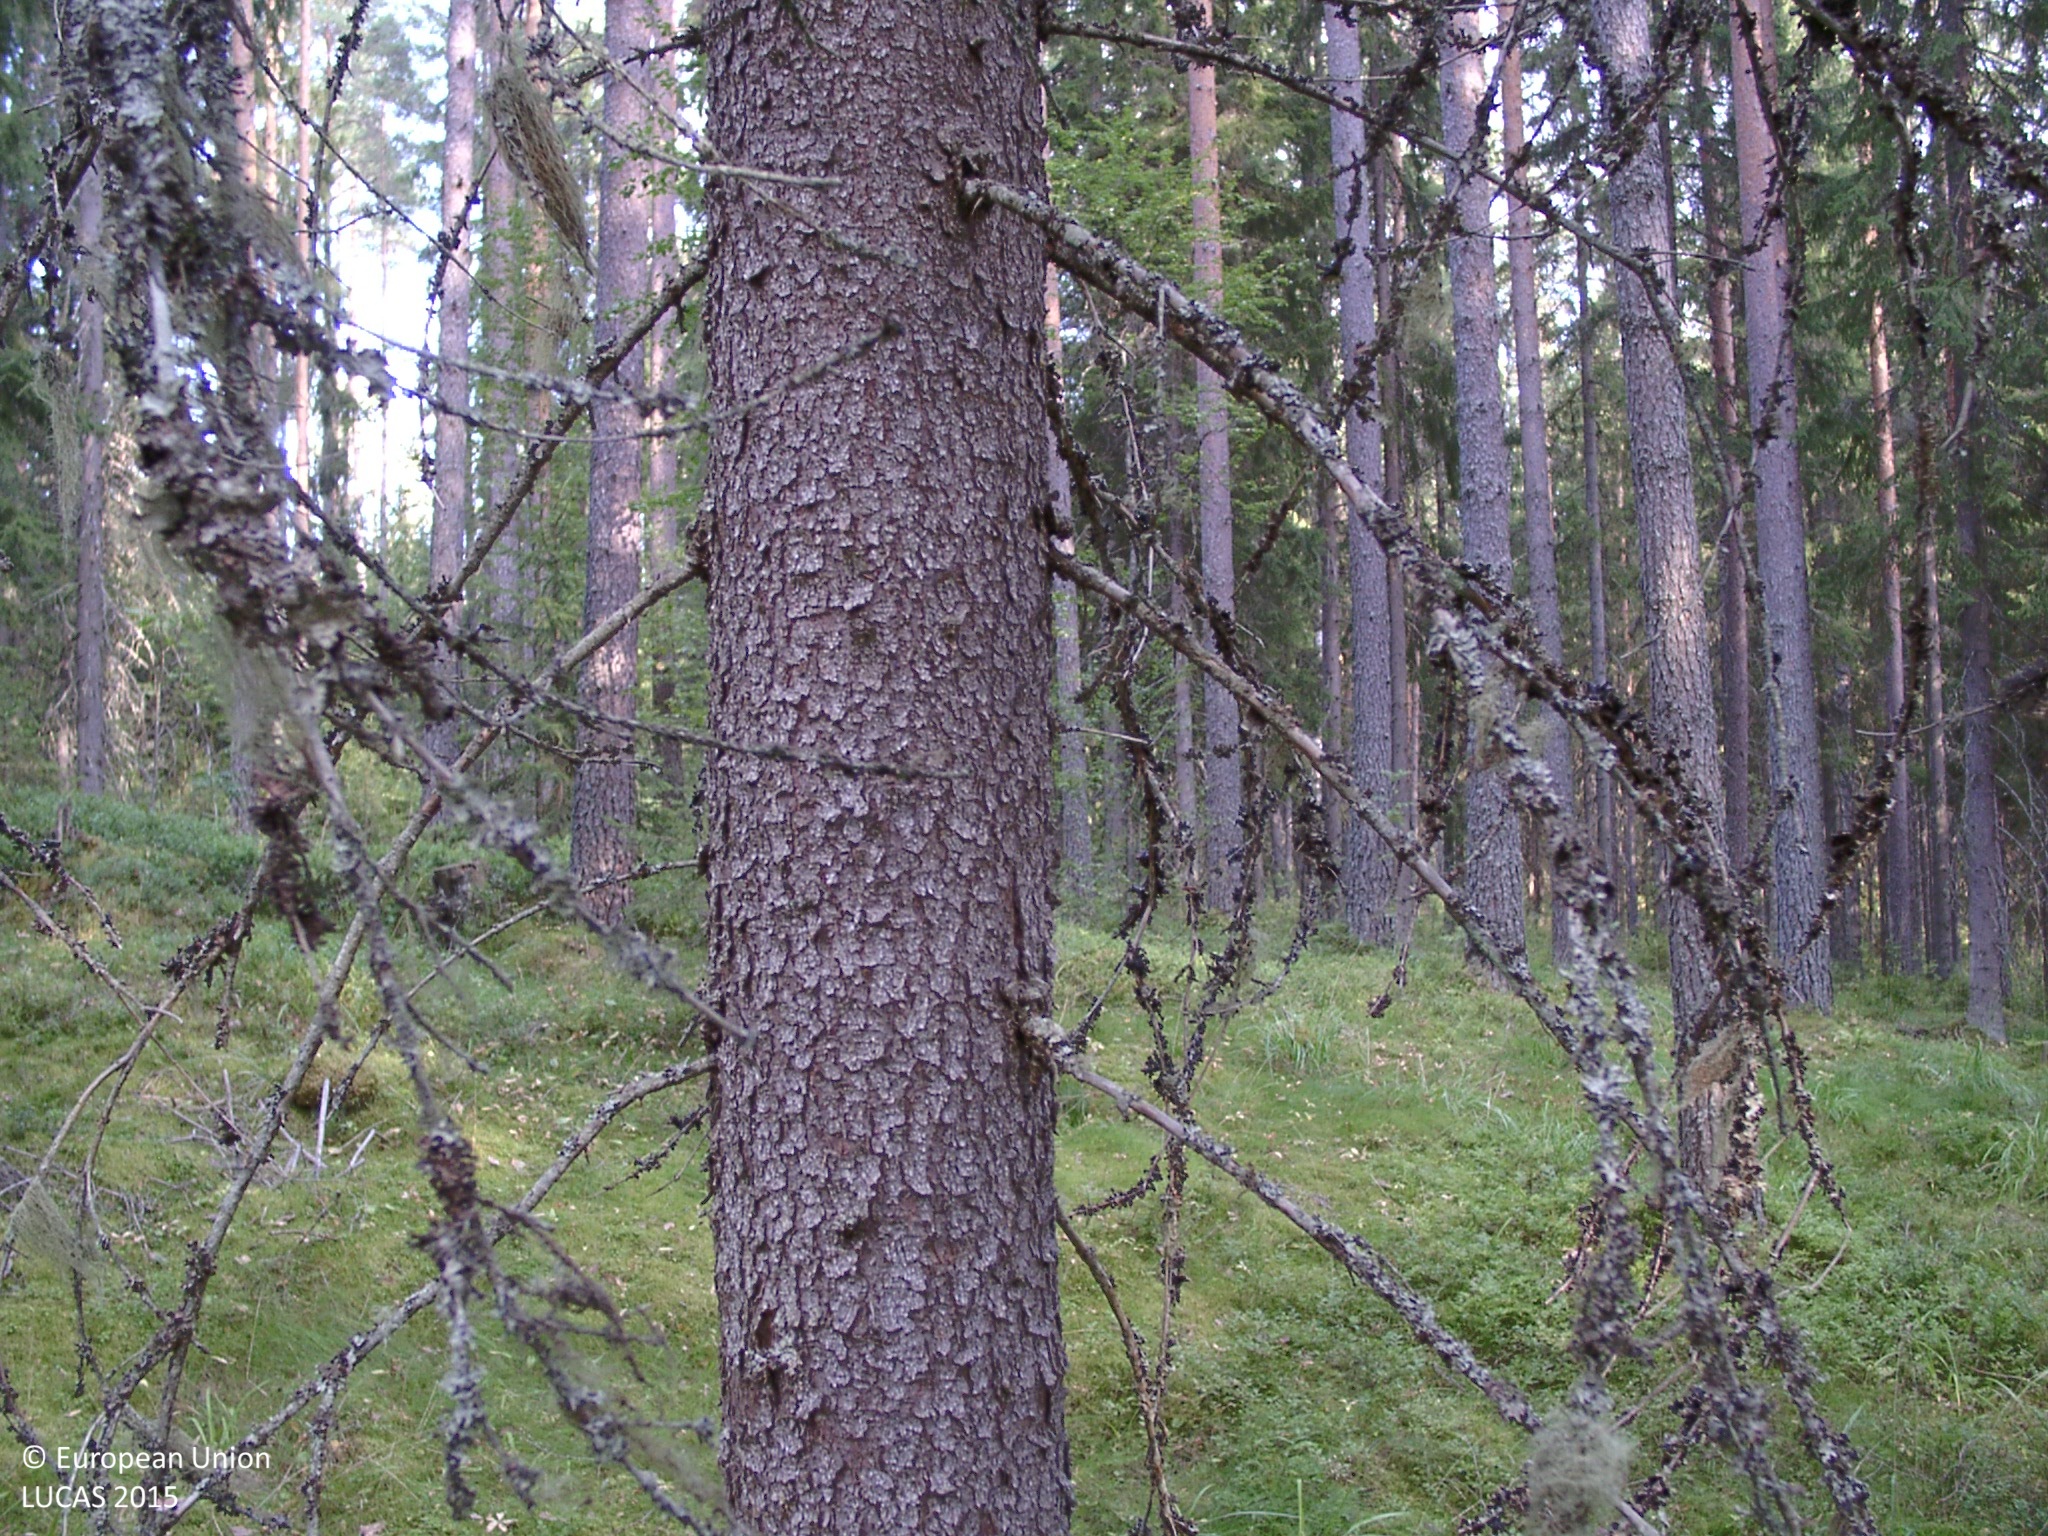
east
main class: Woodland
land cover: Other coniferous woodland
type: boreal forest
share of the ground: 50 - 75 %
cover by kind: coniferous forest trees 65 %, lichens and mosses 15 %, shrubs 10 %, broadleaved forest trees 5 %, herbaceous plants 5 %
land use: Forestry
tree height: > 5 m
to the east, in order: Other coniferous woodland; Shruby margins; Other coniferous woodland; Spruce dominated coniferous woodland; Groves; Inland marshes; Spruce dominated mixed woodland; Spruce dominated coniferous woodland
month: August
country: FI
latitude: 61.7508
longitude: 24.9353
